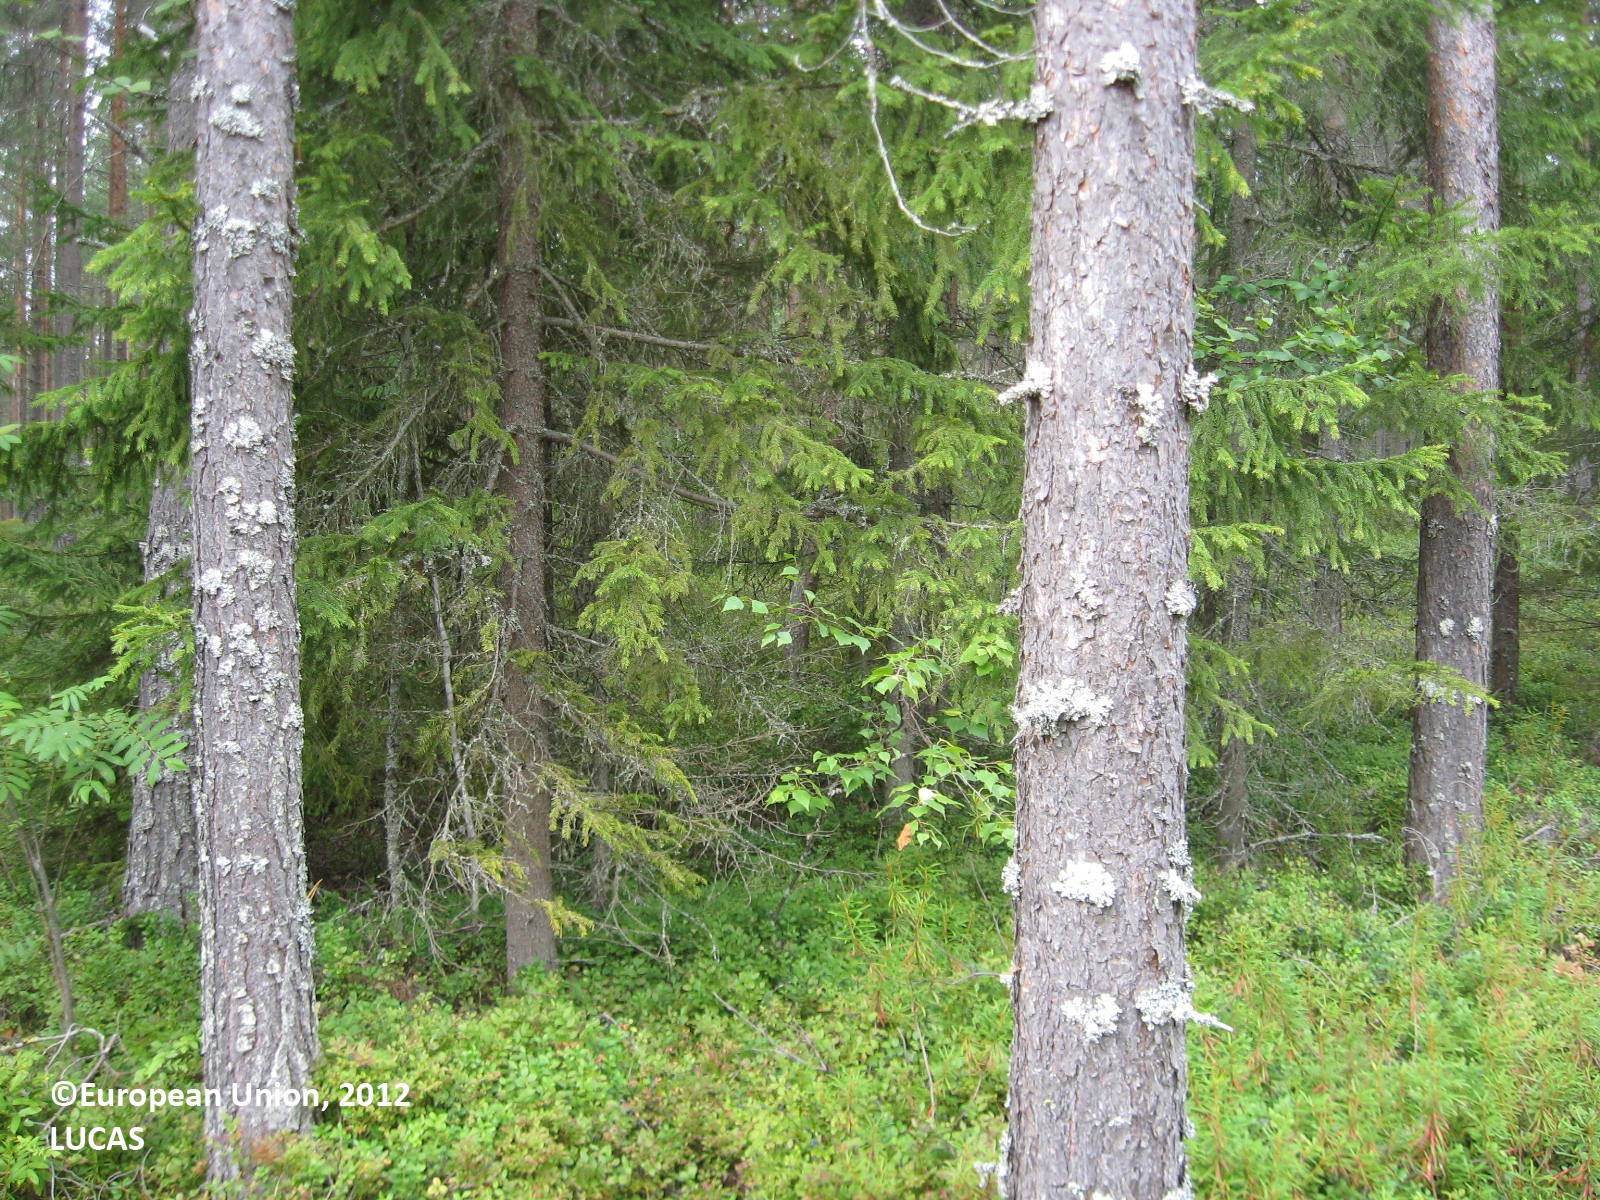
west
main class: Shrubland
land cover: Shrubland with sparse tree cover
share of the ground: > 75 %
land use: Energy production
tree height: < 5 m
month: August
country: FI
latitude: 63.4416
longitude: 29.4092
